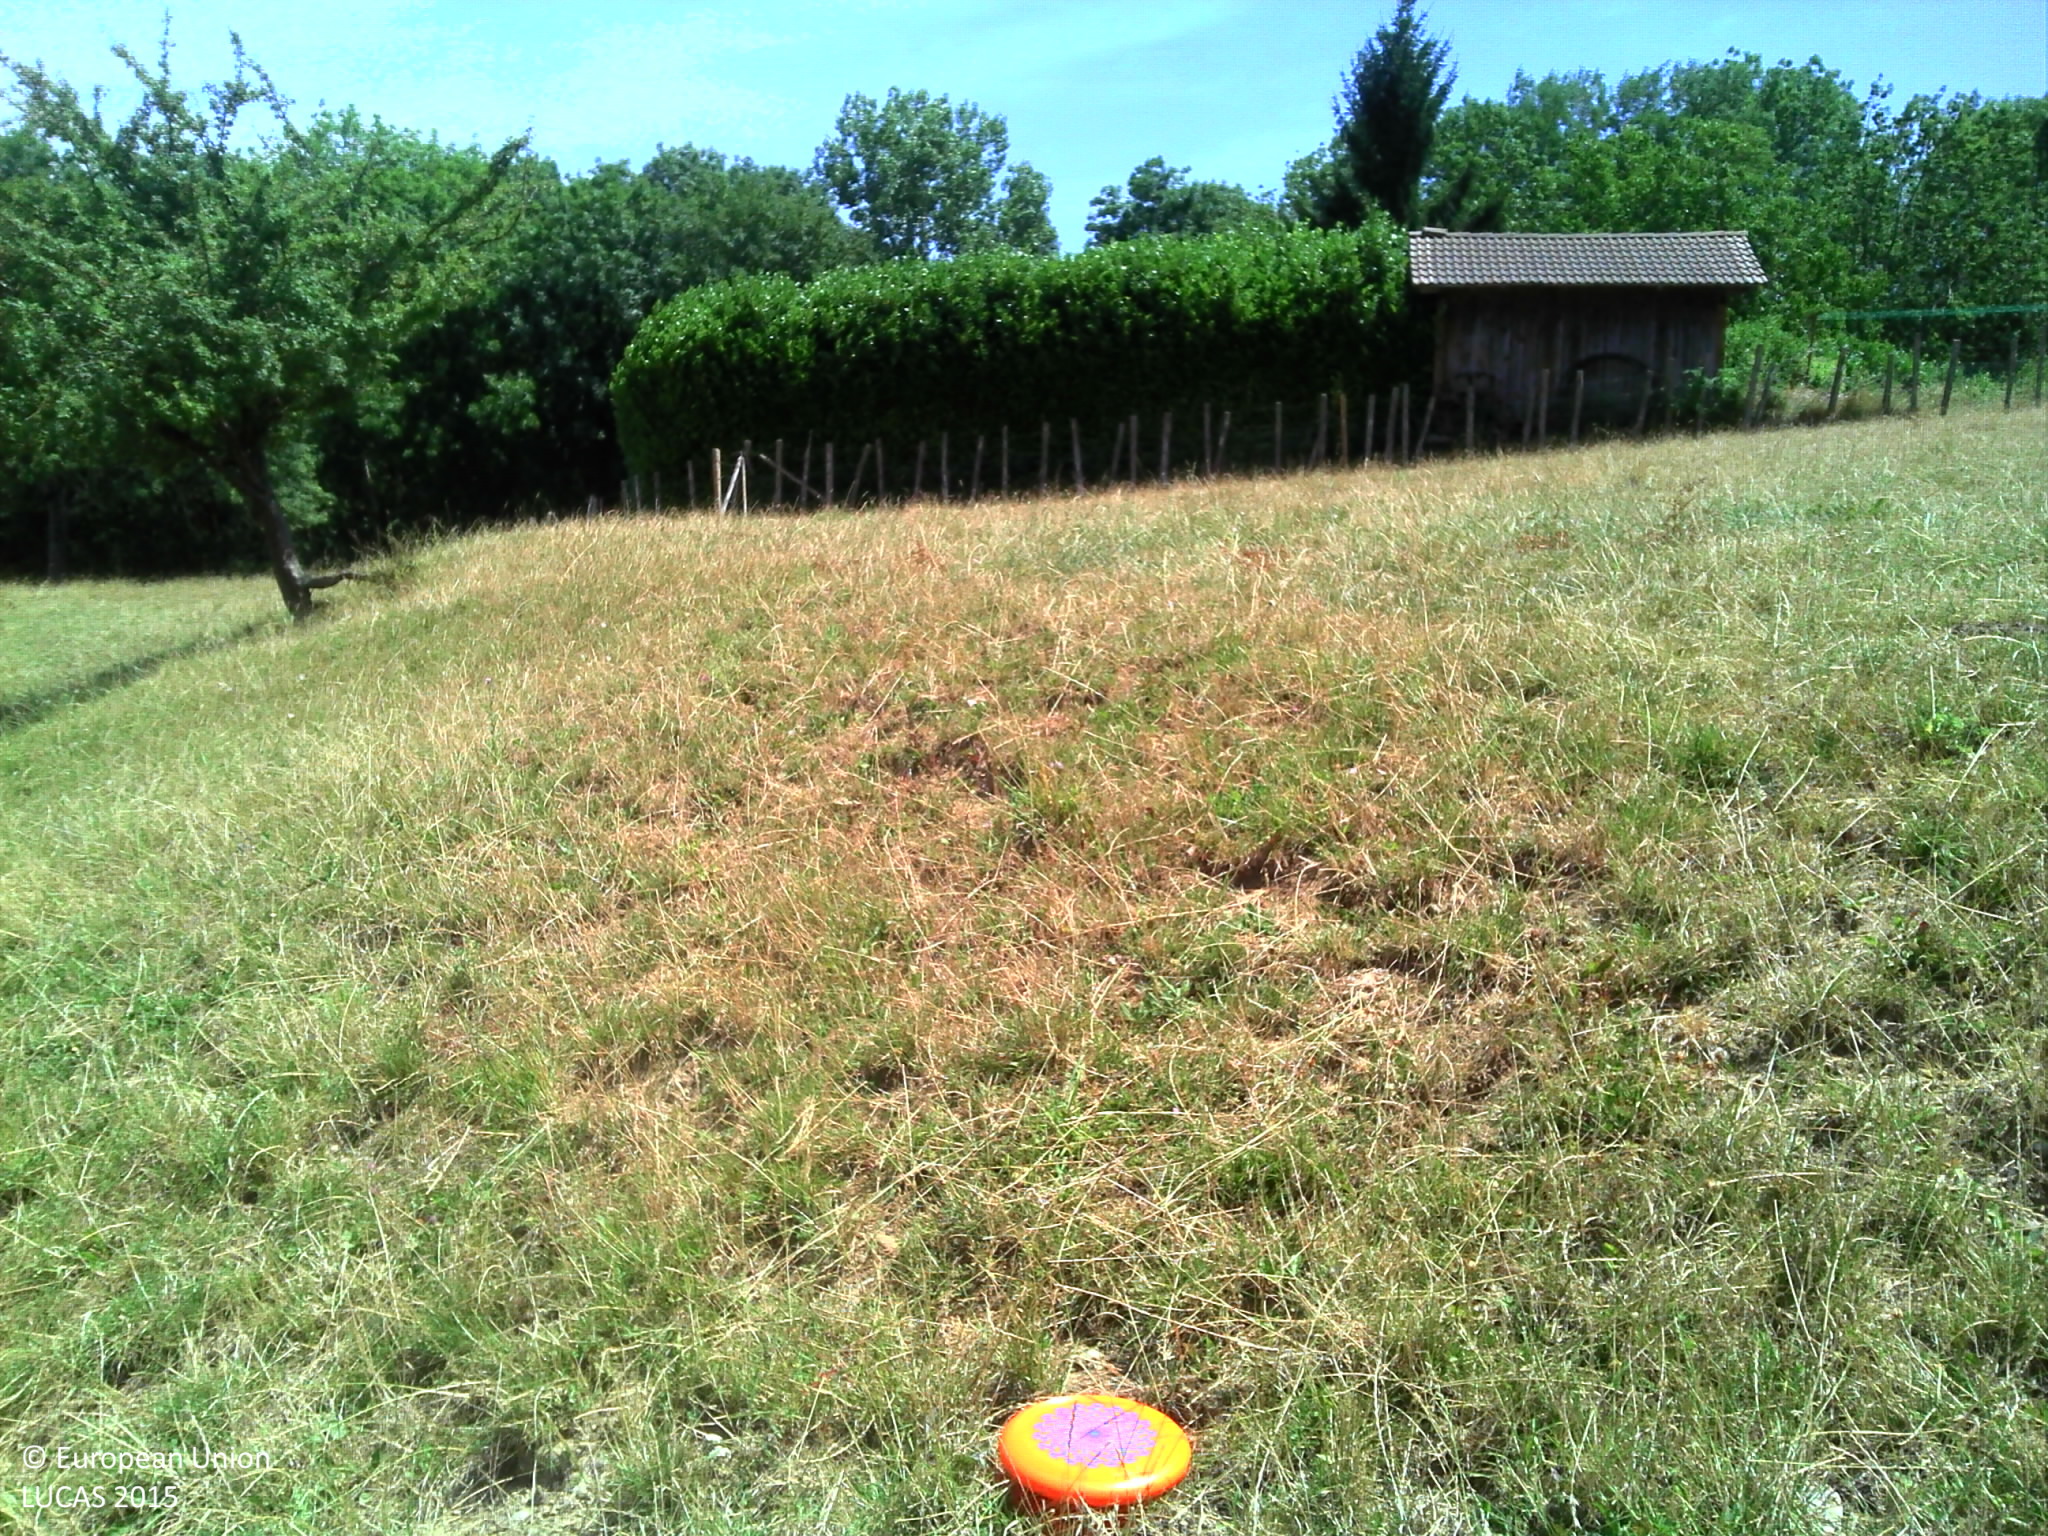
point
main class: Grassland
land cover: Grassland with sparse tree/shrub cover
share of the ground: > 75 %
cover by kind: herbaceous plants 90 %, broadleaved forest trees 5 %, consolidated bare surface 5 %
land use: Agriculture (excluding fallow land and kitchen gardens)
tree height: > 5 m
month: July
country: FR
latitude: 45.3049
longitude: 5.1968
